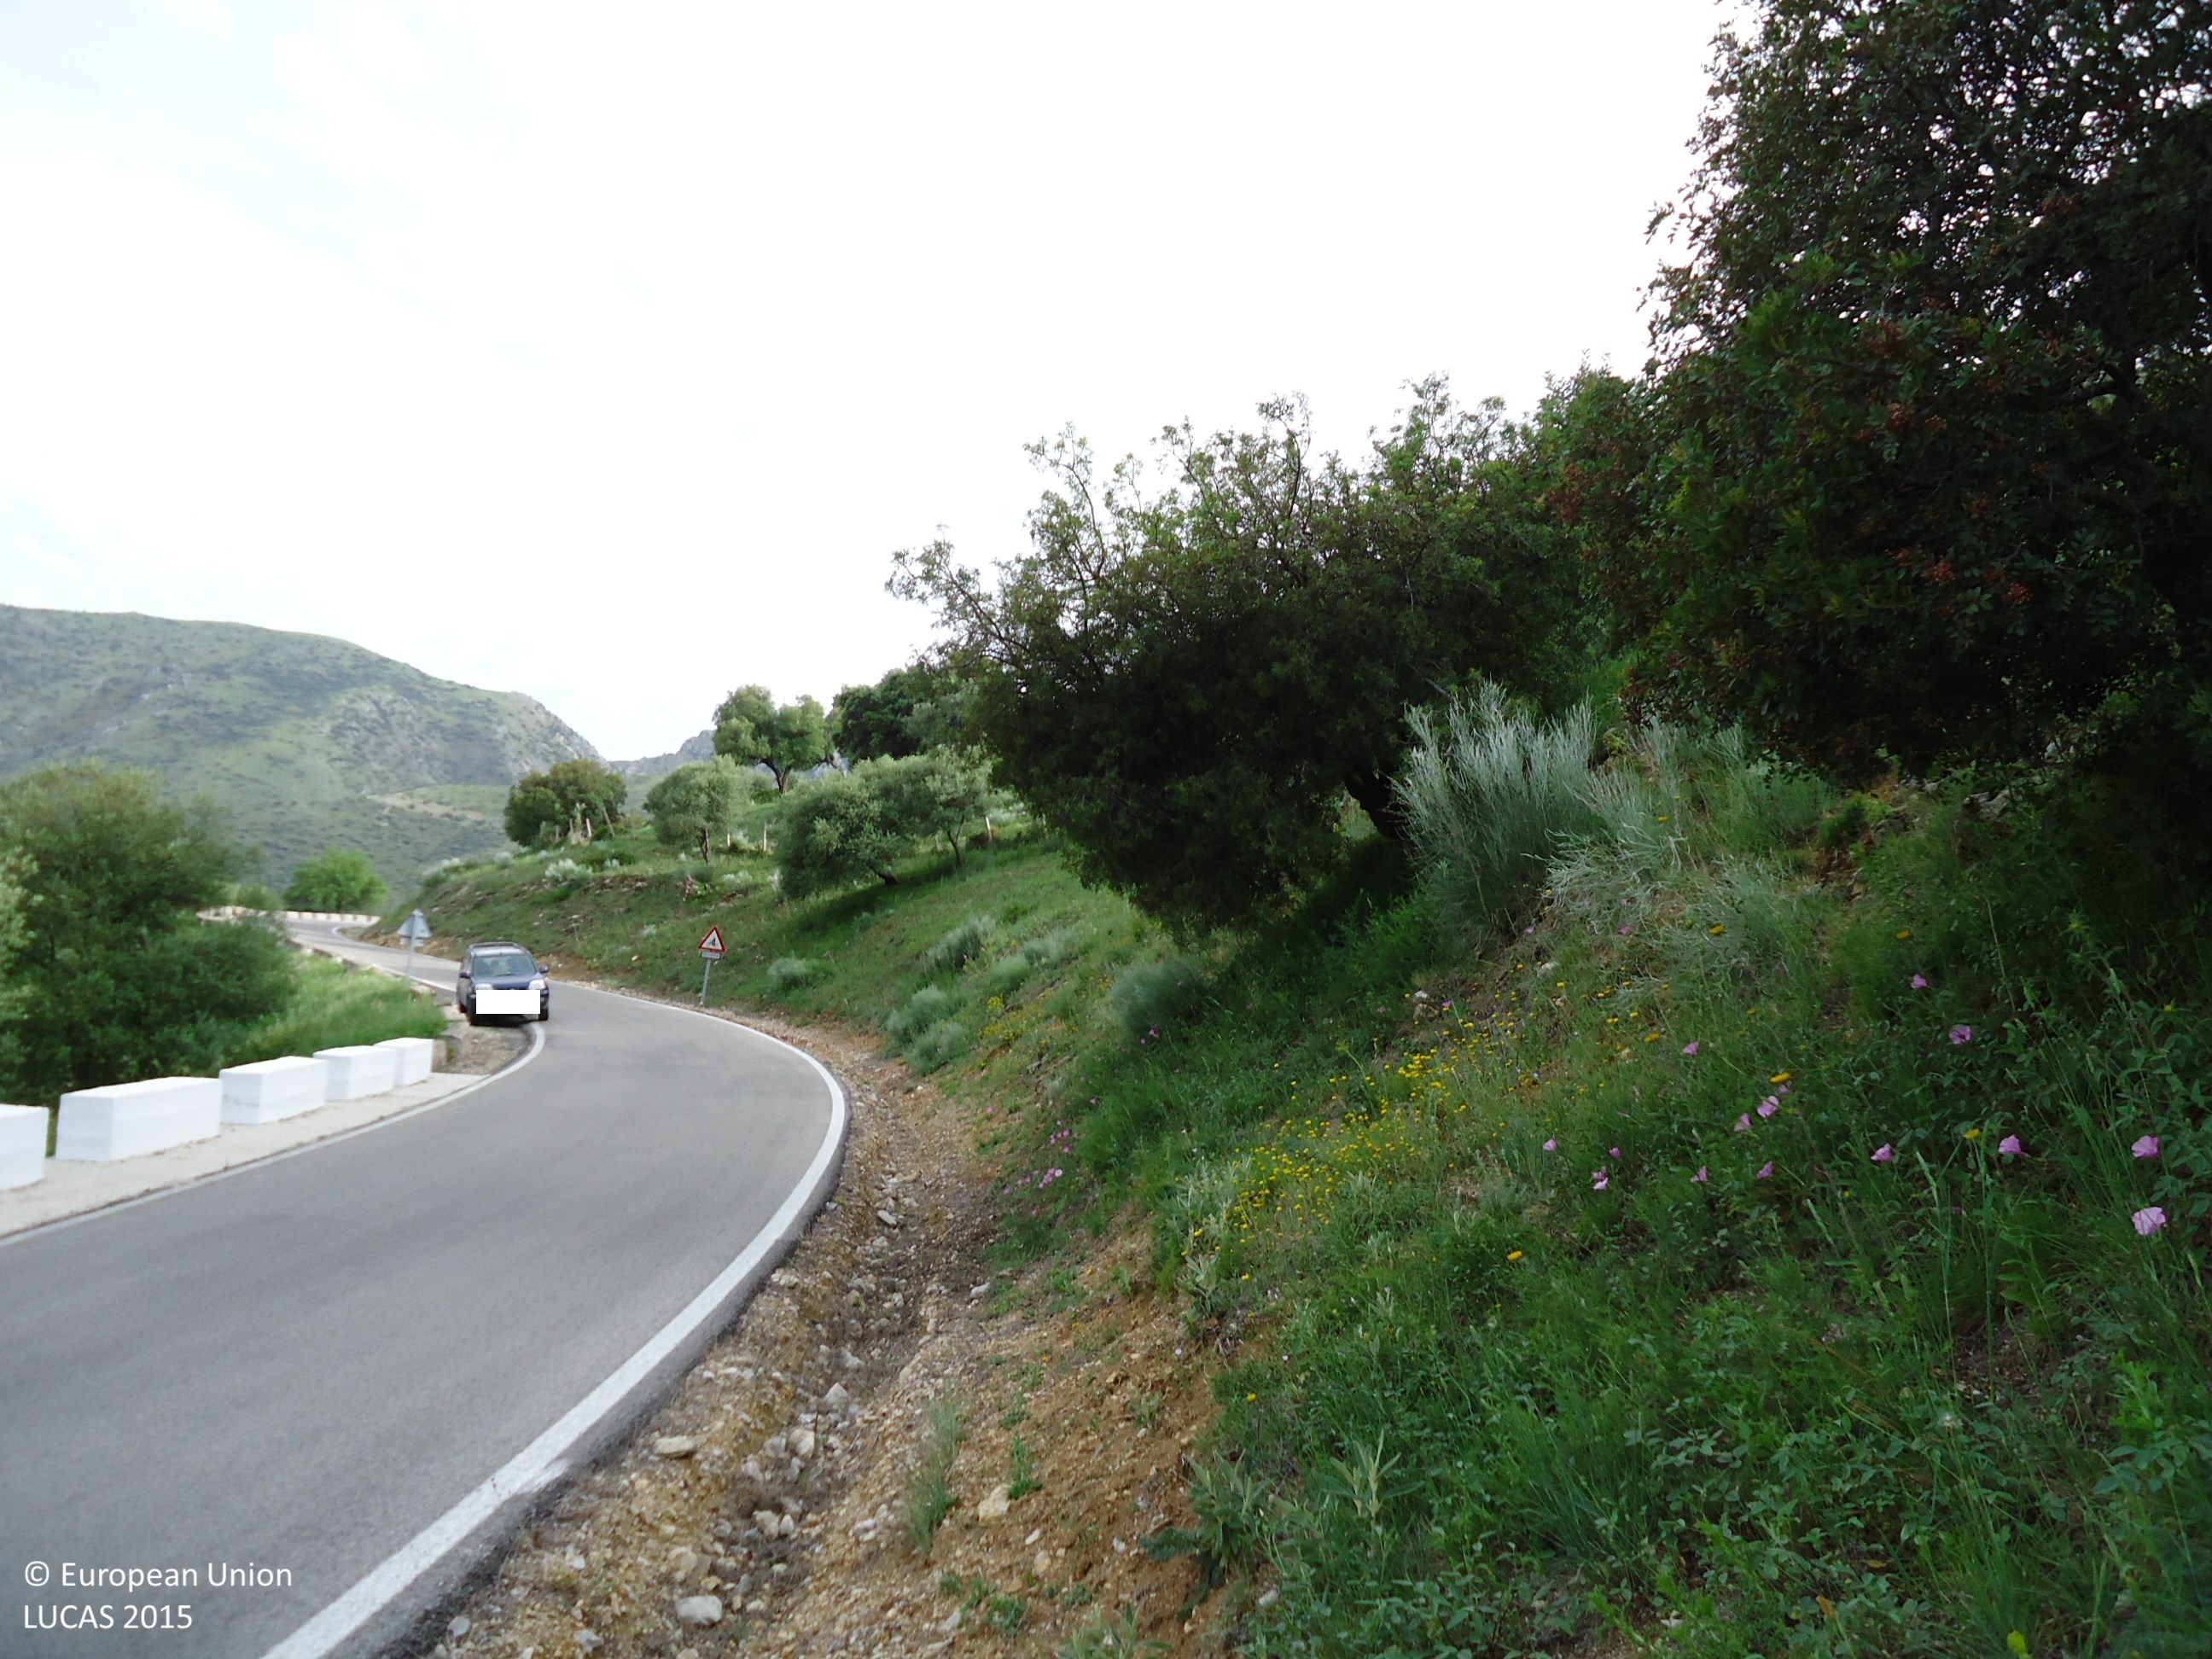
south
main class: Woodland
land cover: Broadleaved woodland
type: broadleaved evergreen forest
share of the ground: 10 - 25 %
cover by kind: herbaceous plants 75 %, broadleaved forest trees 20 %, shrubs 5 %
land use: Forestry
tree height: > 5 m
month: May
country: ES
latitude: 36.8173
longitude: -5.3954
